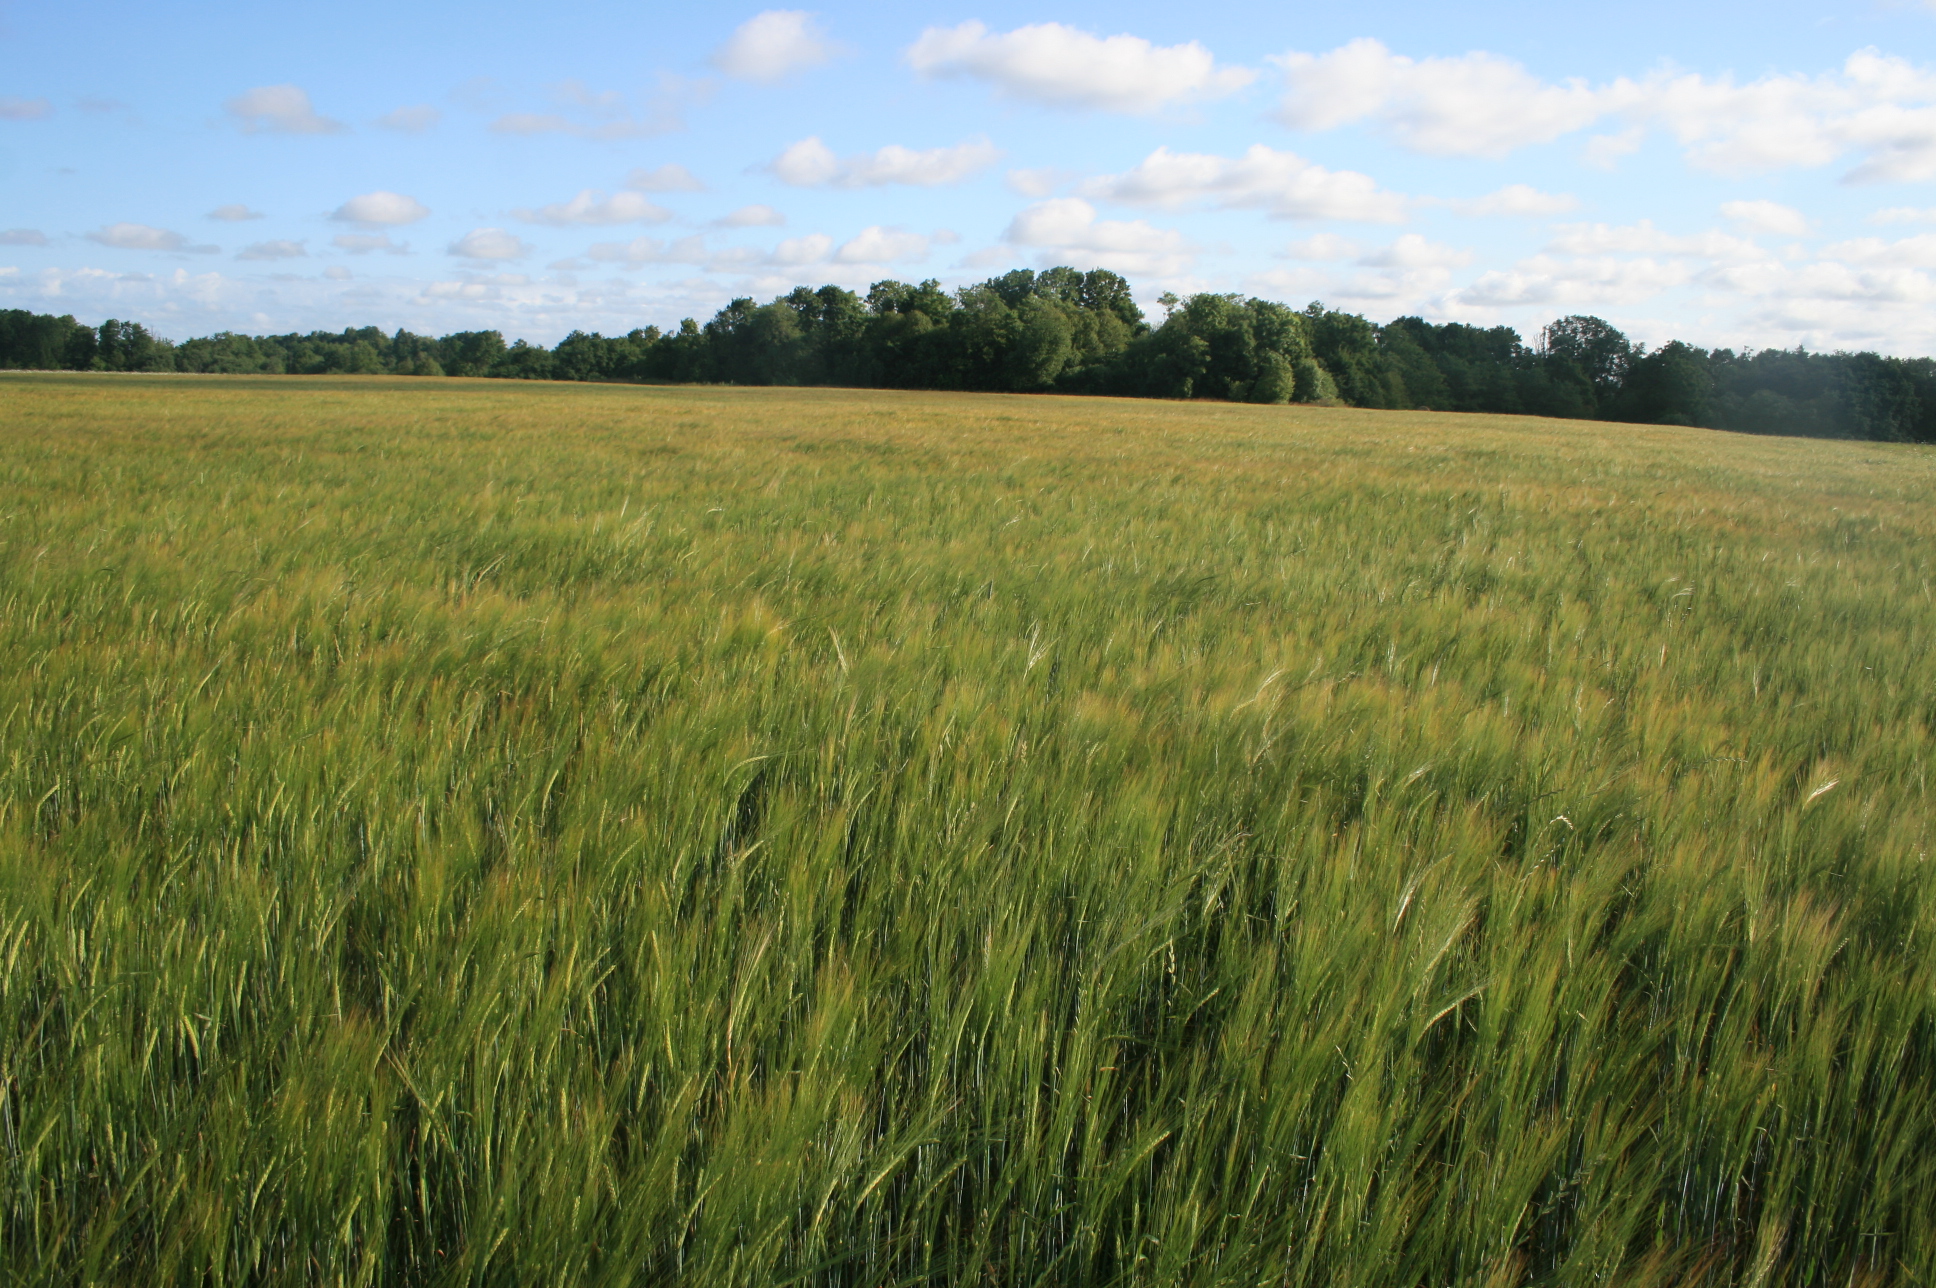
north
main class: Cropland
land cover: Barley
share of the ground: > 75 %
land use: Agriculture (excluding fallow land and kitchen gardens)
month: July
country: LT
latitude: 55.8381
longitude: 21.2346
